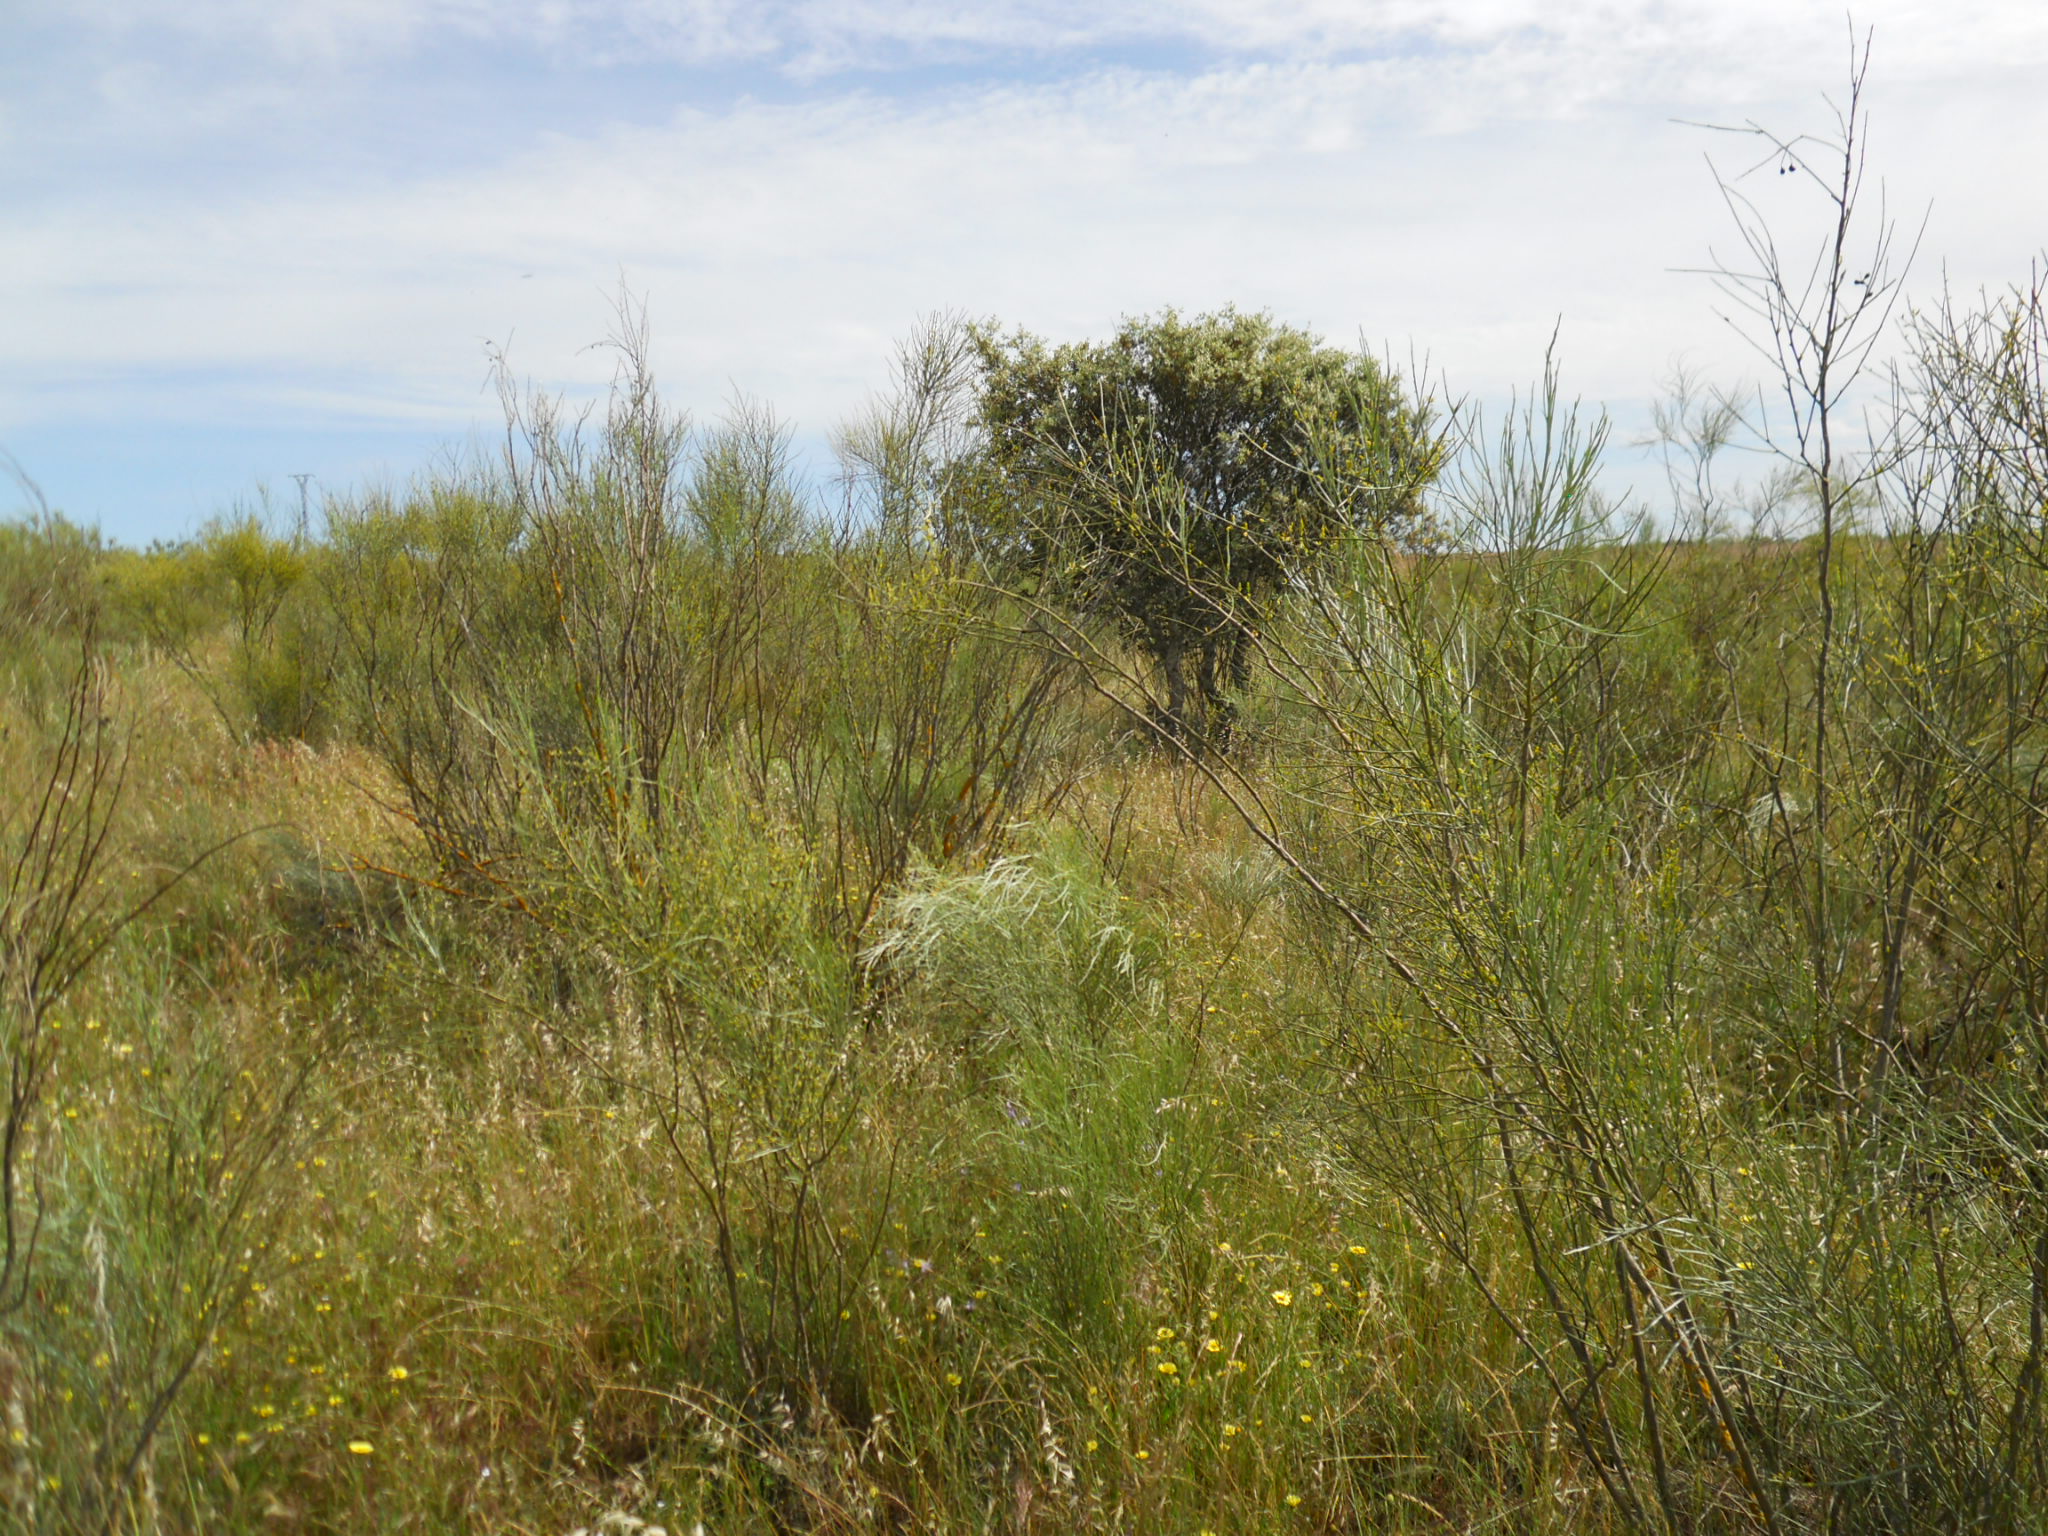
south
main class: Shrubland
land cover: Shrubland with sparse tree cover
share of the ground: 50 - 75 %
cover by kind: shrubs 80 %, herbaceous plants 15 %, broadleaved forest trees 5 %
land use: Agriculture (excluding fallow land and kitchen gardens)
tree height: < 5 m
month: May
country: ES
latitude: 39.3466
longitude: -6.3449
